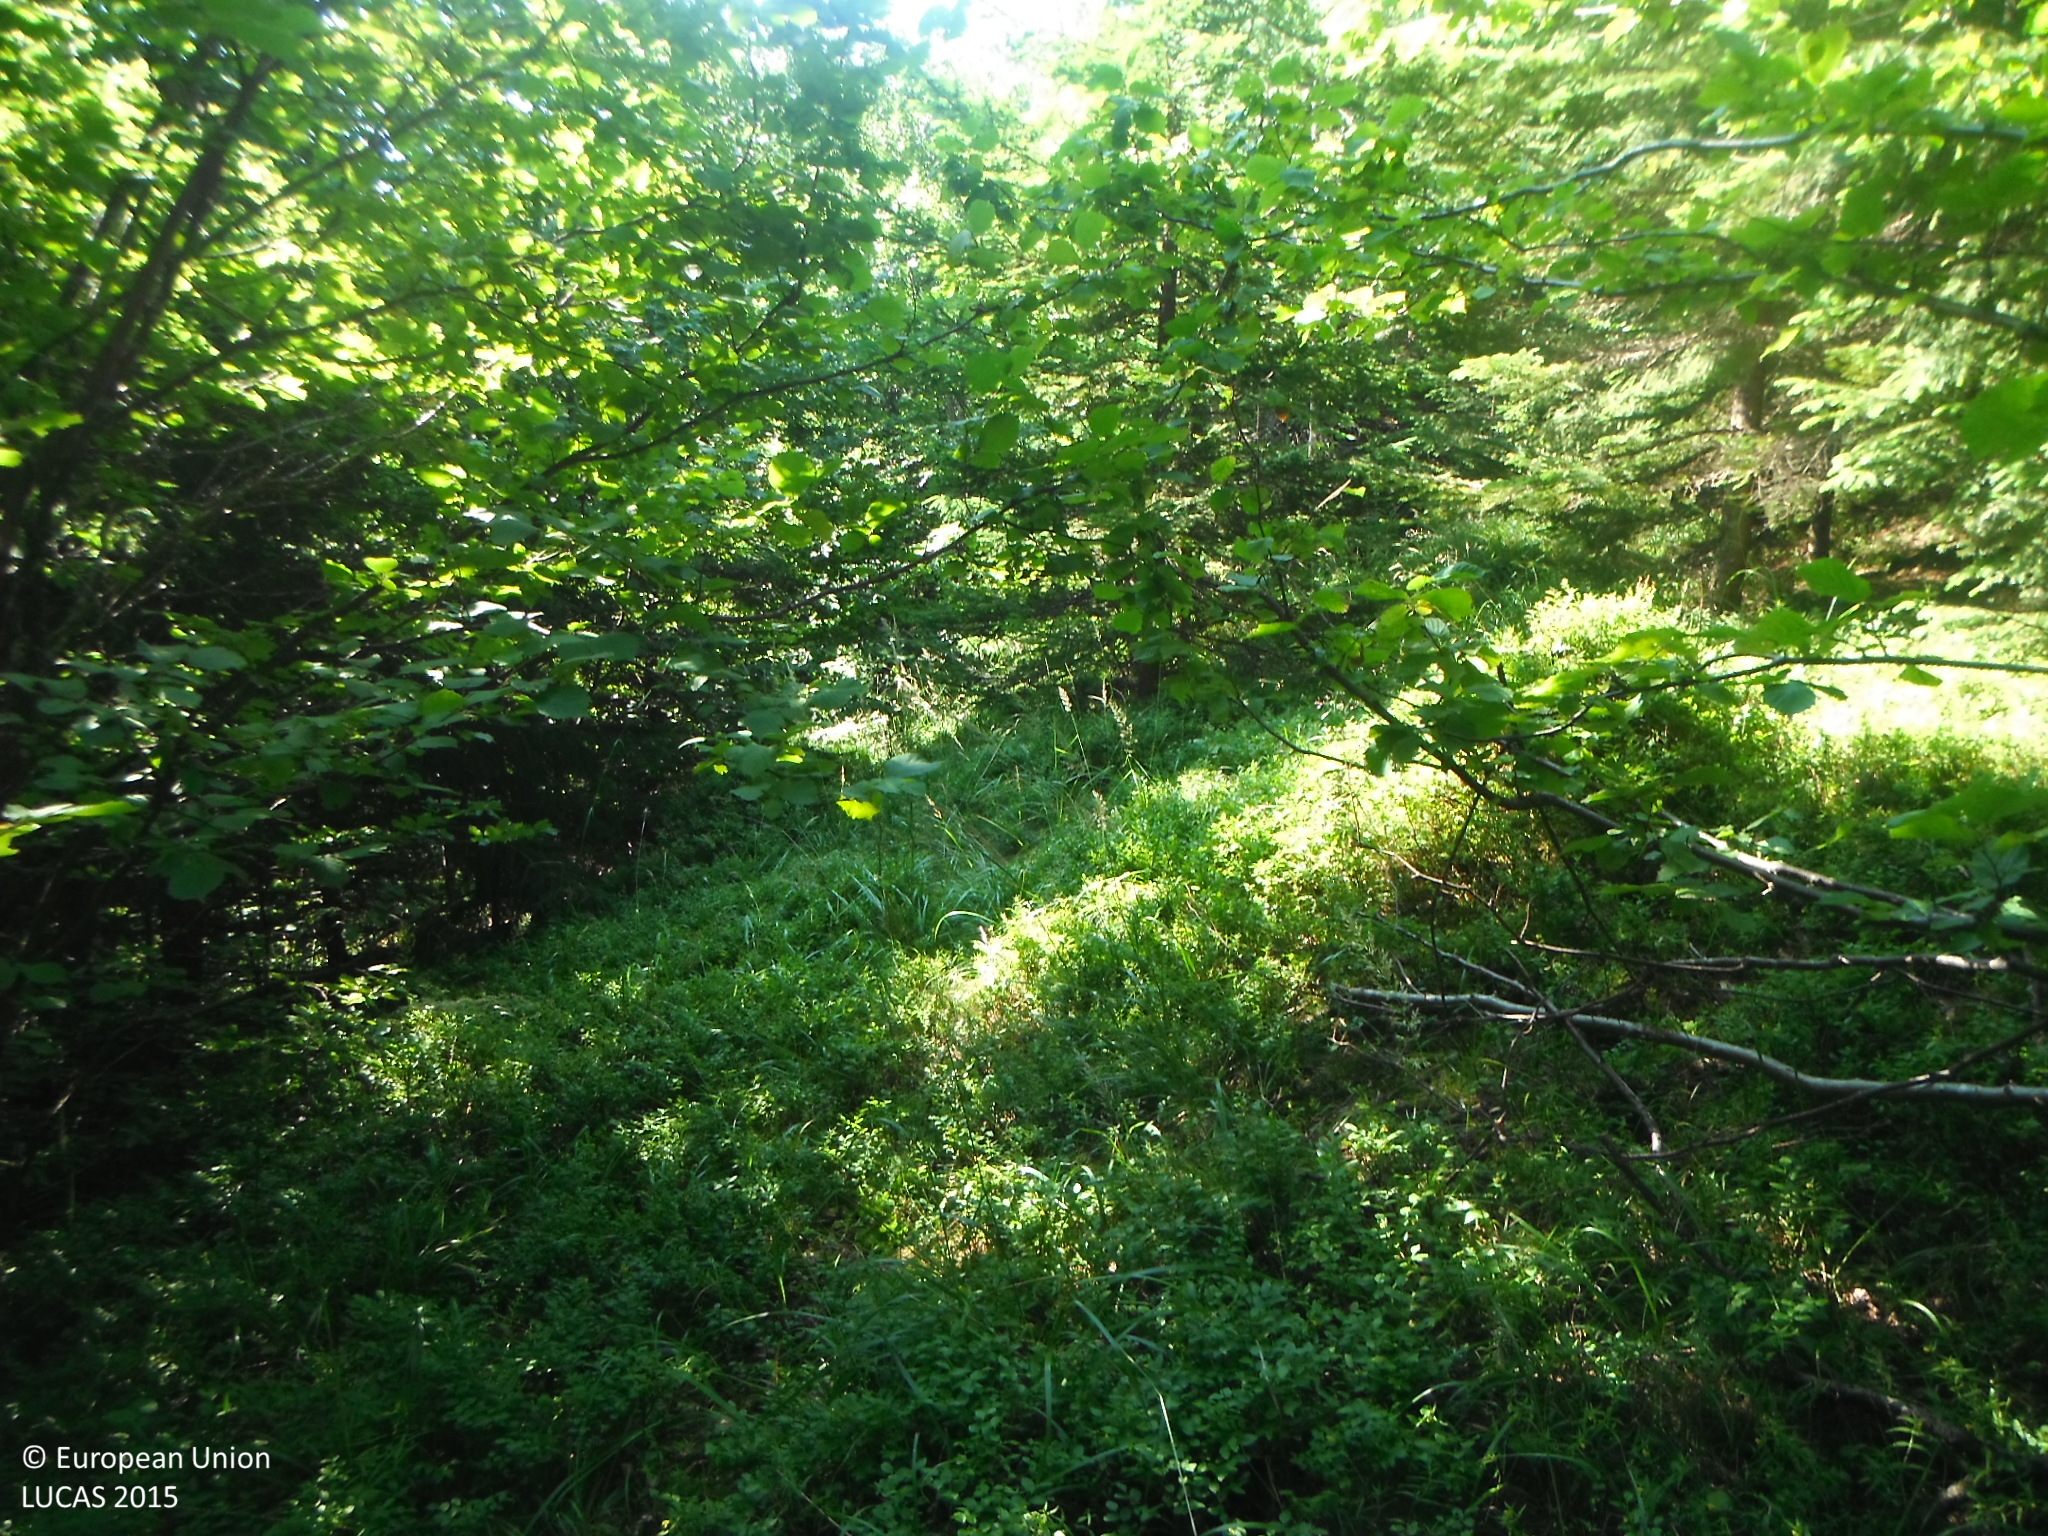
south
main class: Woodland
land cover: Spruce dominated mixed woodland
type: hemiboreal forest and nemoral coniferous forest and mixed broadleaved-coniferous forest
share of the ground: > 75 %
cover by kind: coniferous forest trees 60 %, broadleaved forest trees 40 %
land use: Forestry
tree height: > 5 m
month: July
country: SK
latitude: 48.9228
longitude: 20.2554
